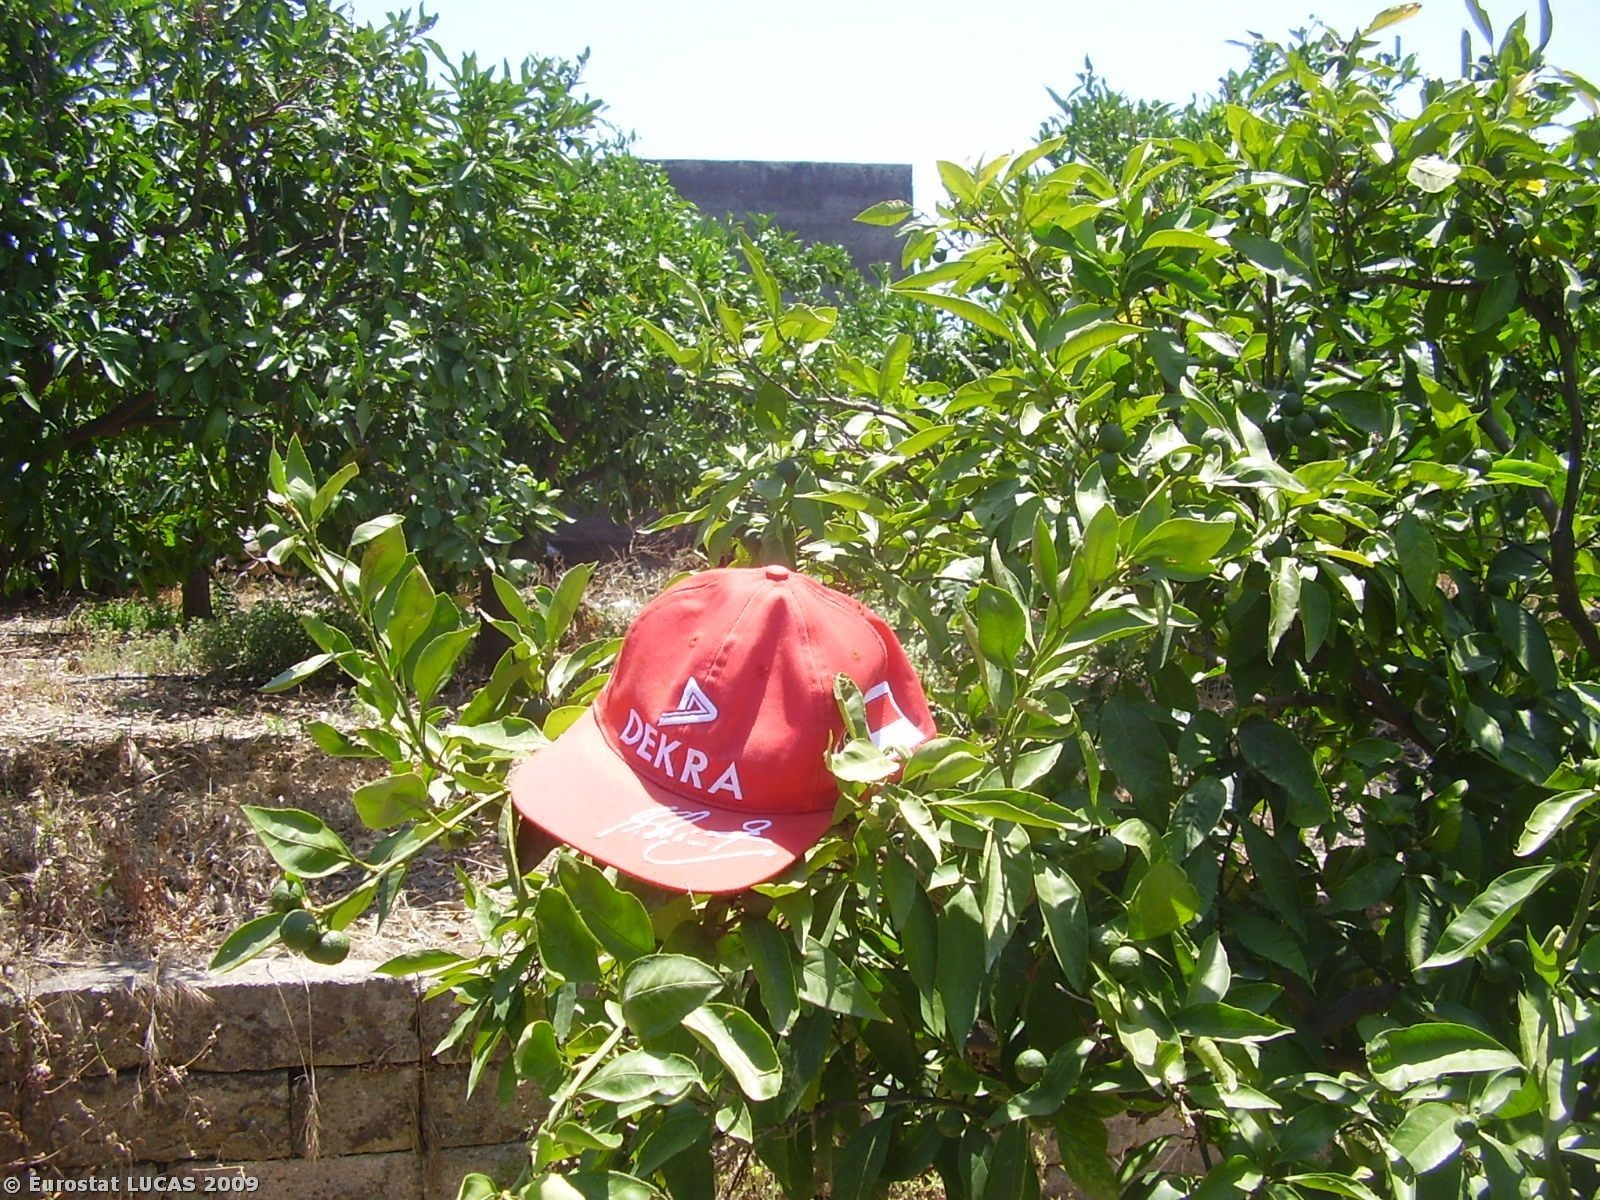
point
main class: Cropland
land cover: Oranges
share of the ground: 25 - 50 %
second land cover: Bare land
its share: > 75 %
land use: Agriculture (excluding fallow land and kitchen gardens)
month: June
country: IT
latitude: 37.5117
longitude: 14.9085
